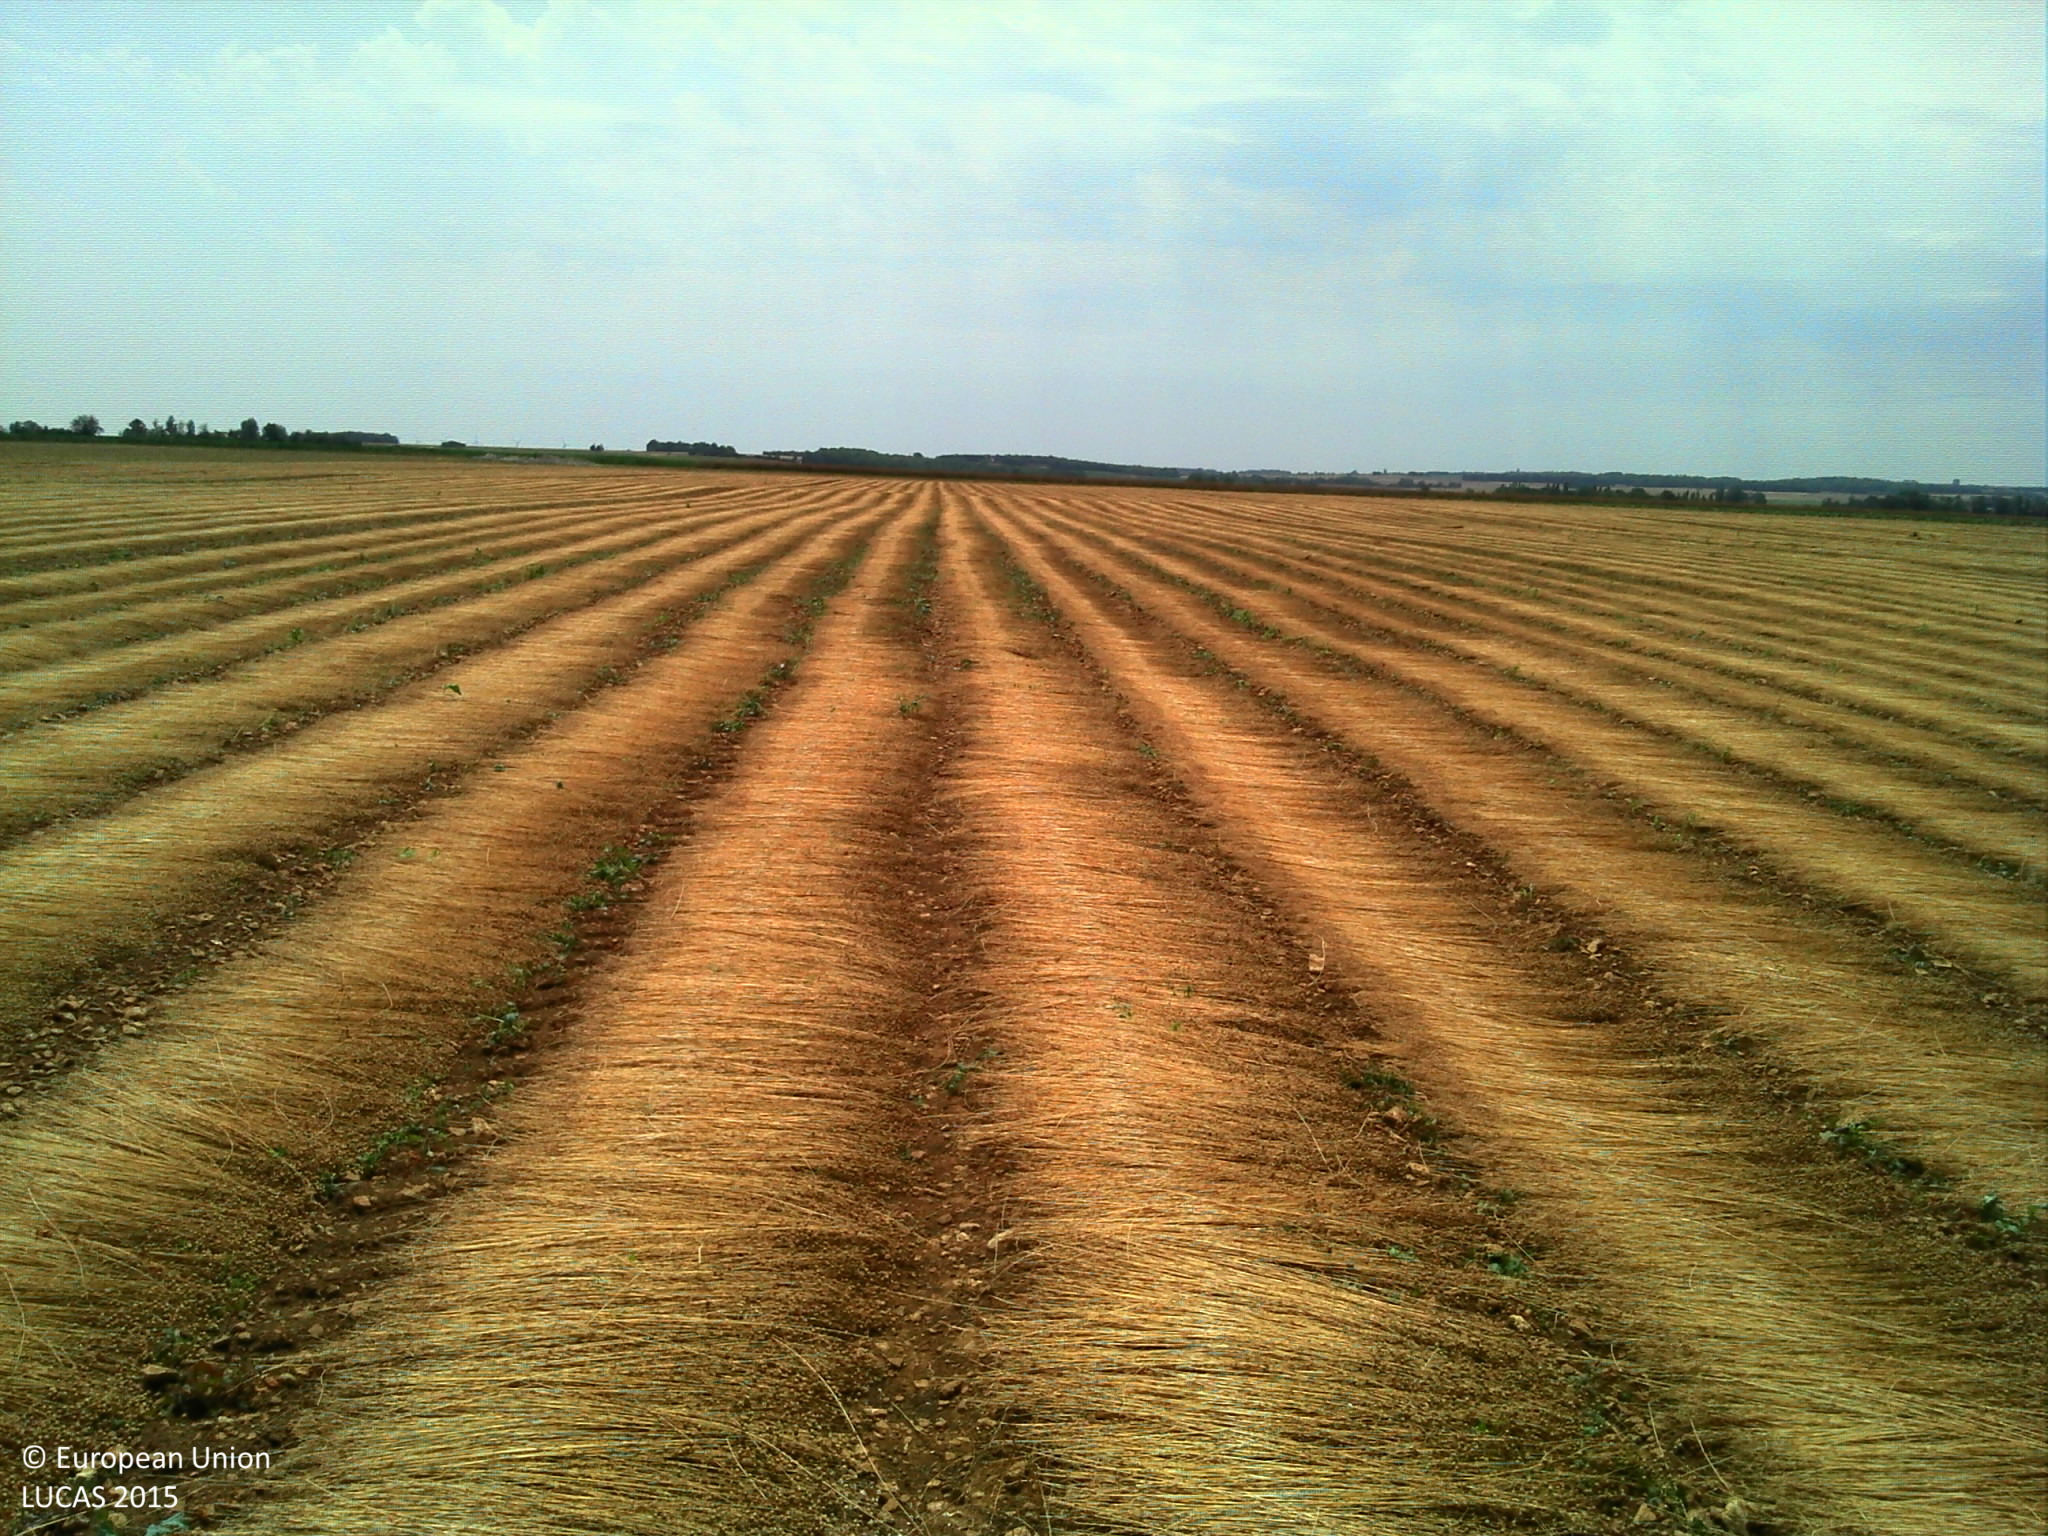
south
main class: Cropland
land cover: Other fibre and oleaginous crops
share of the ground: > 75 %
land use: Agriculture (excluding fallow land and kitchen gardens)
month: July
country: FR
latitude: 49.0370
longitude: -0.1963
